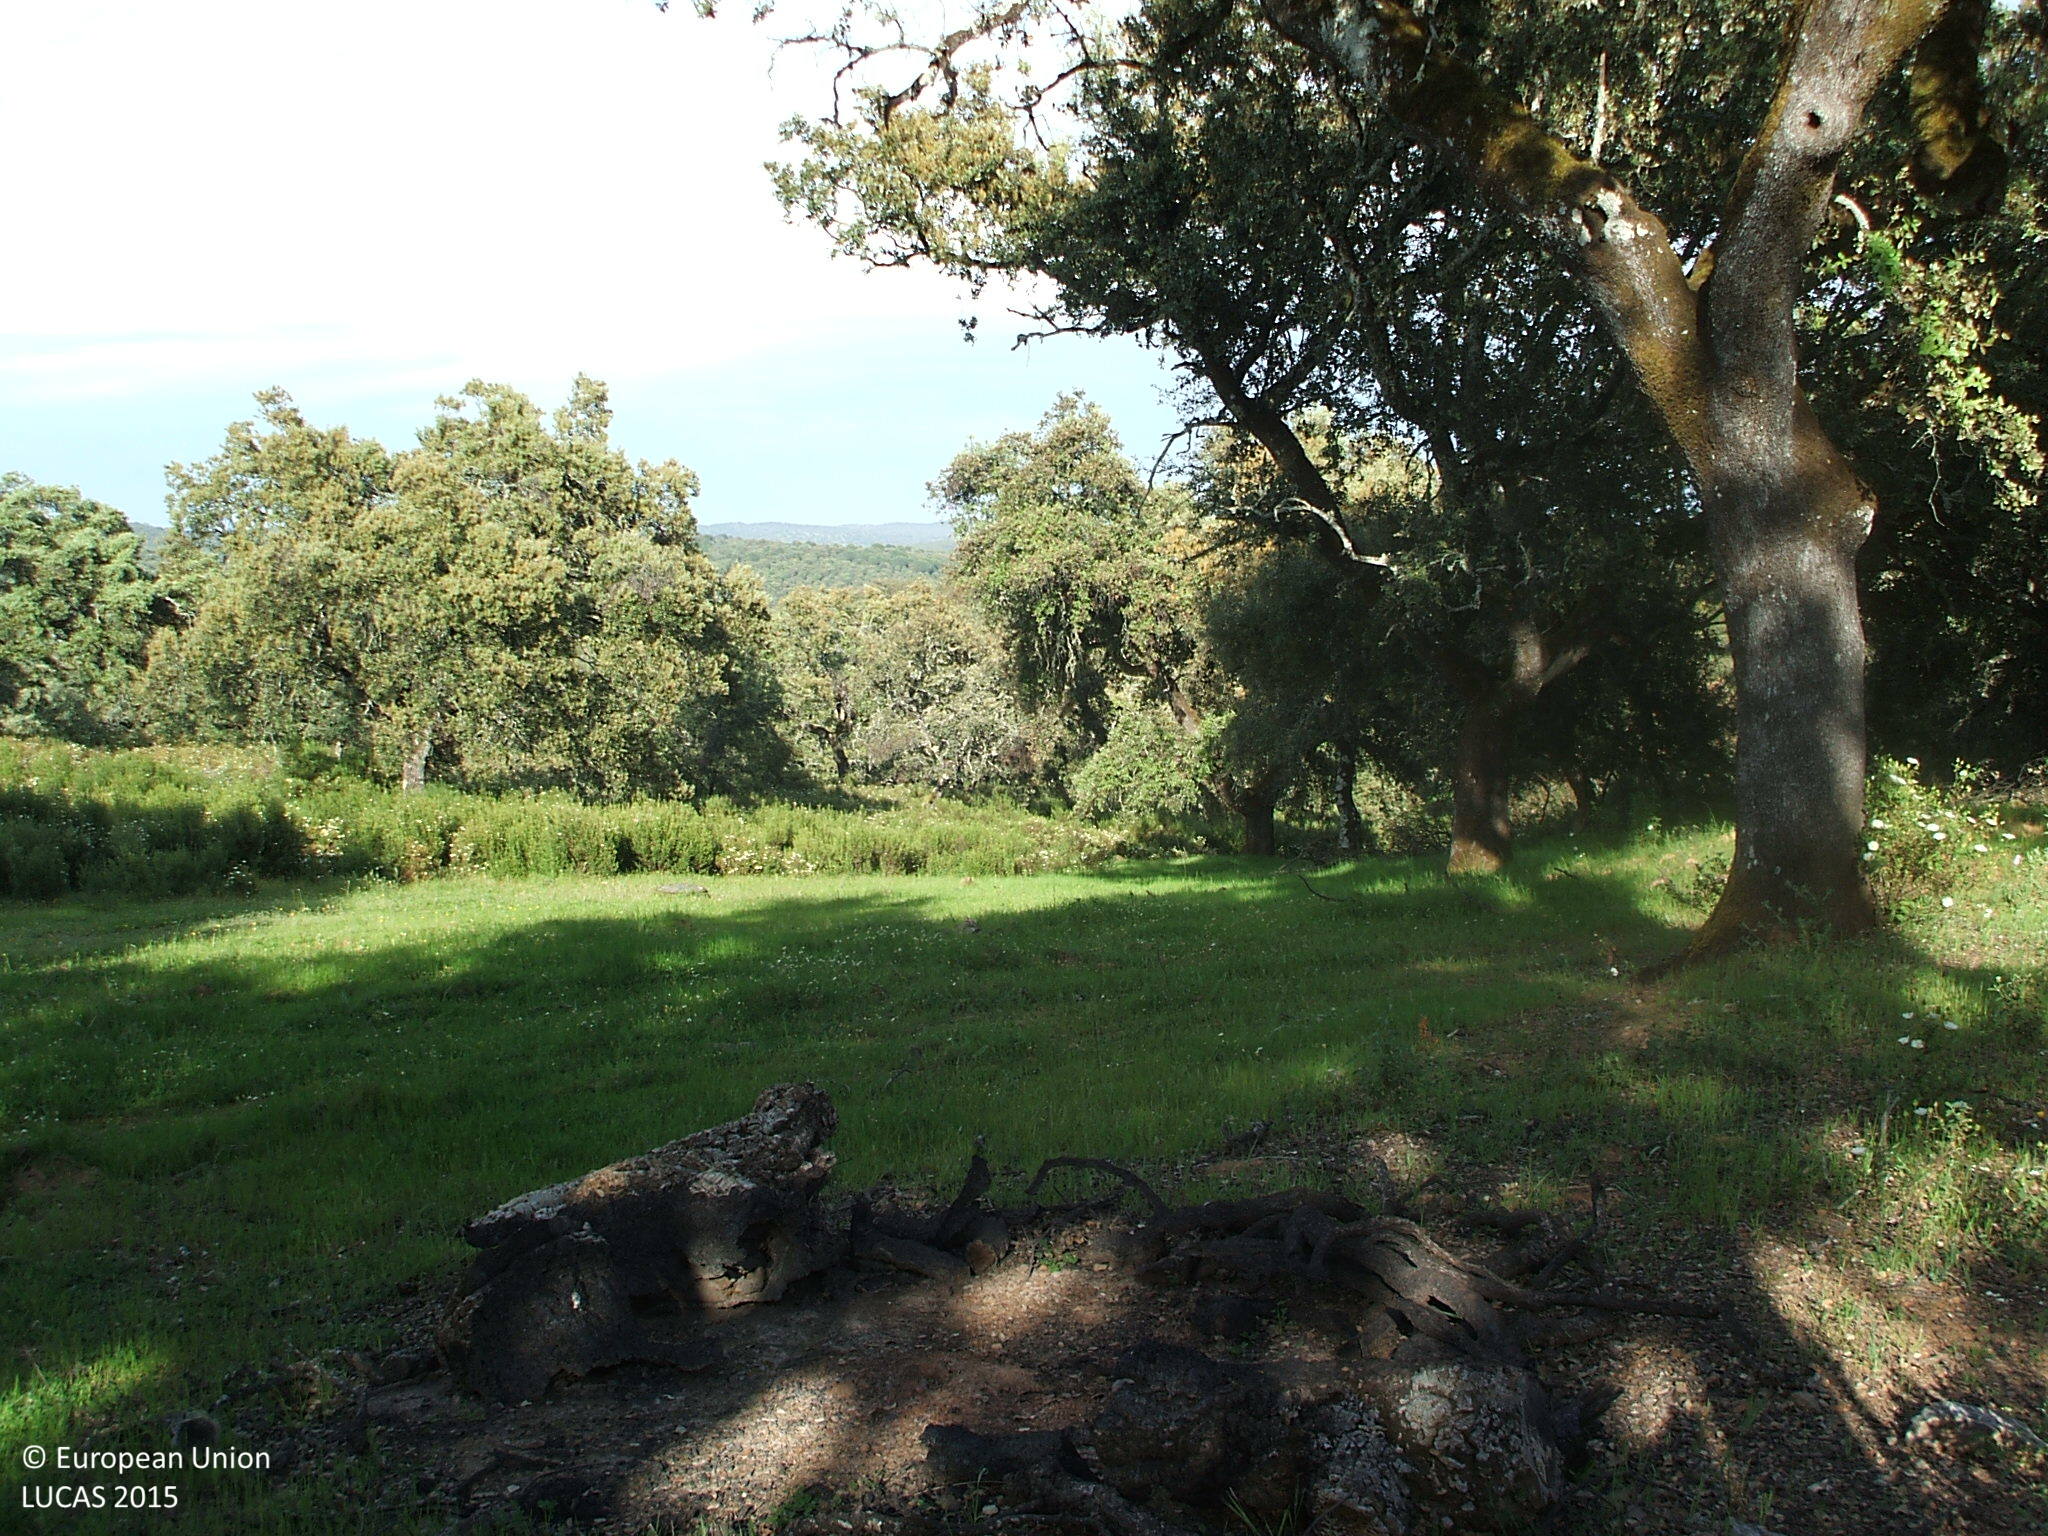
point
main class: Woodland
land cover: Broadleaved woodland
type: broadleaved evergreen forest
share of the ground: 10 - 25 %
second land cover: Grassland without tree/shrub cover
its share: > 75 %
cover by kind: herbaceous plants 80 %, broadleaved forest trees 20 %
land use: Forestry
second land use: Agriculture (excluding fallow land and kitchen gardens)
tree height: > 5 m
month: April
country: ES
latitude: 38.0202
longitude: -5.6931
